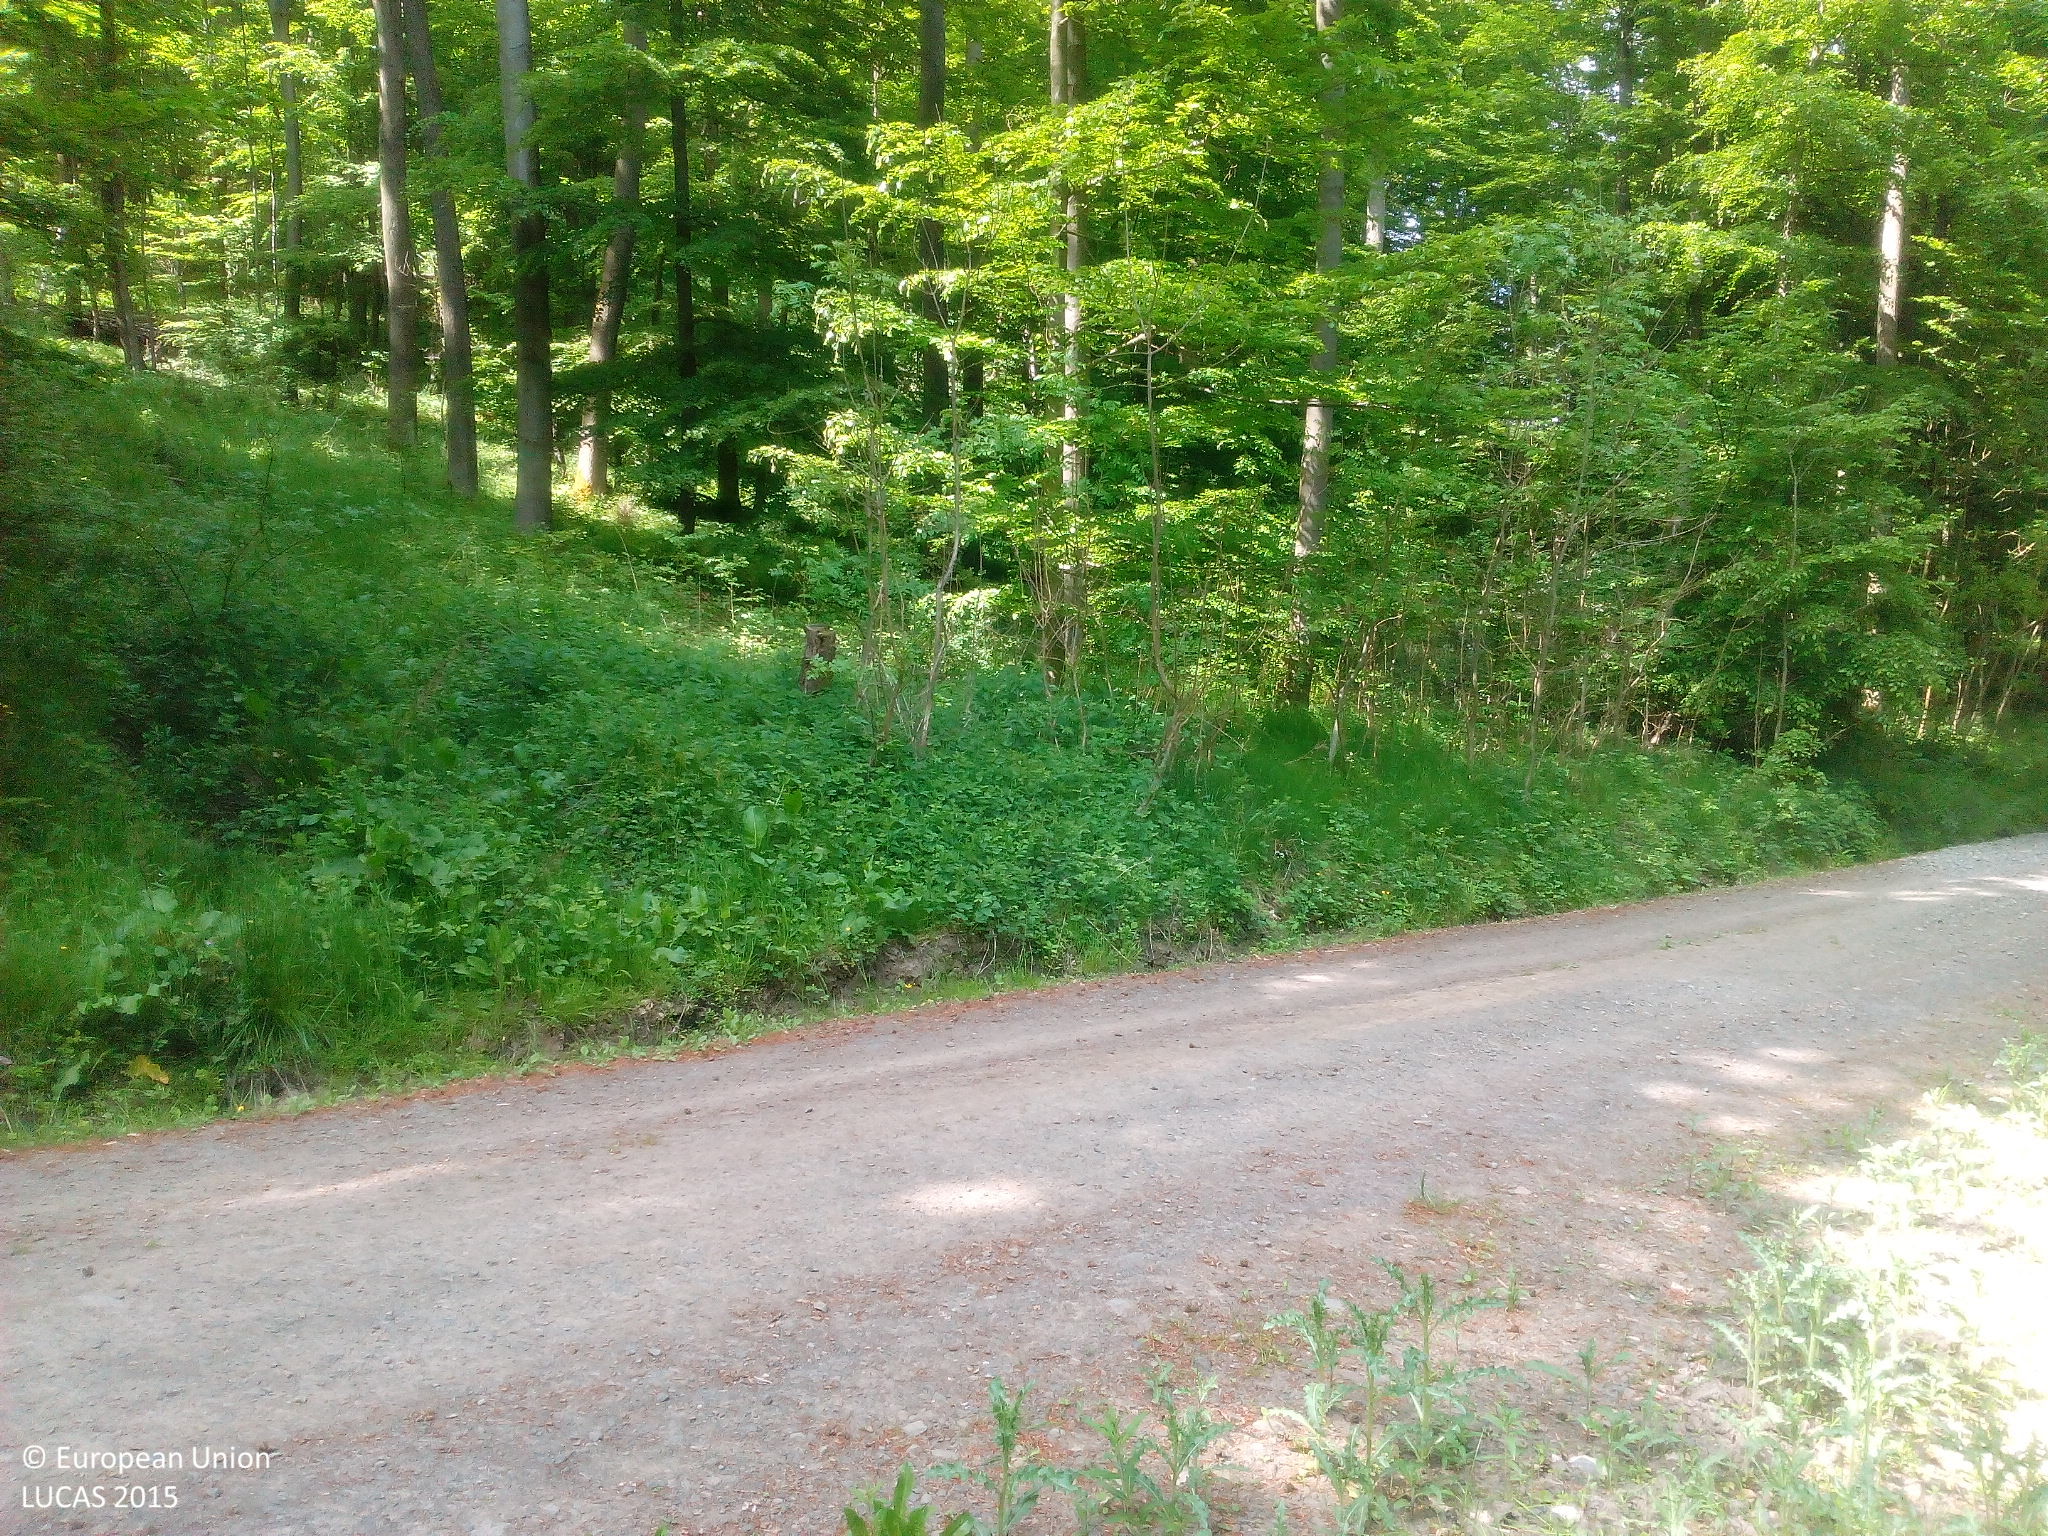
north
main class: Woodland
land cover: Broadleaved woodland
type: beech forest
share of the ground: > 75 %
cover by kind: broadleaved forest trees 100 %
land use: Forestry
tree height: > 5 m
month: May
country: DE
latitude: 51.3511
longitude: 9.3541
